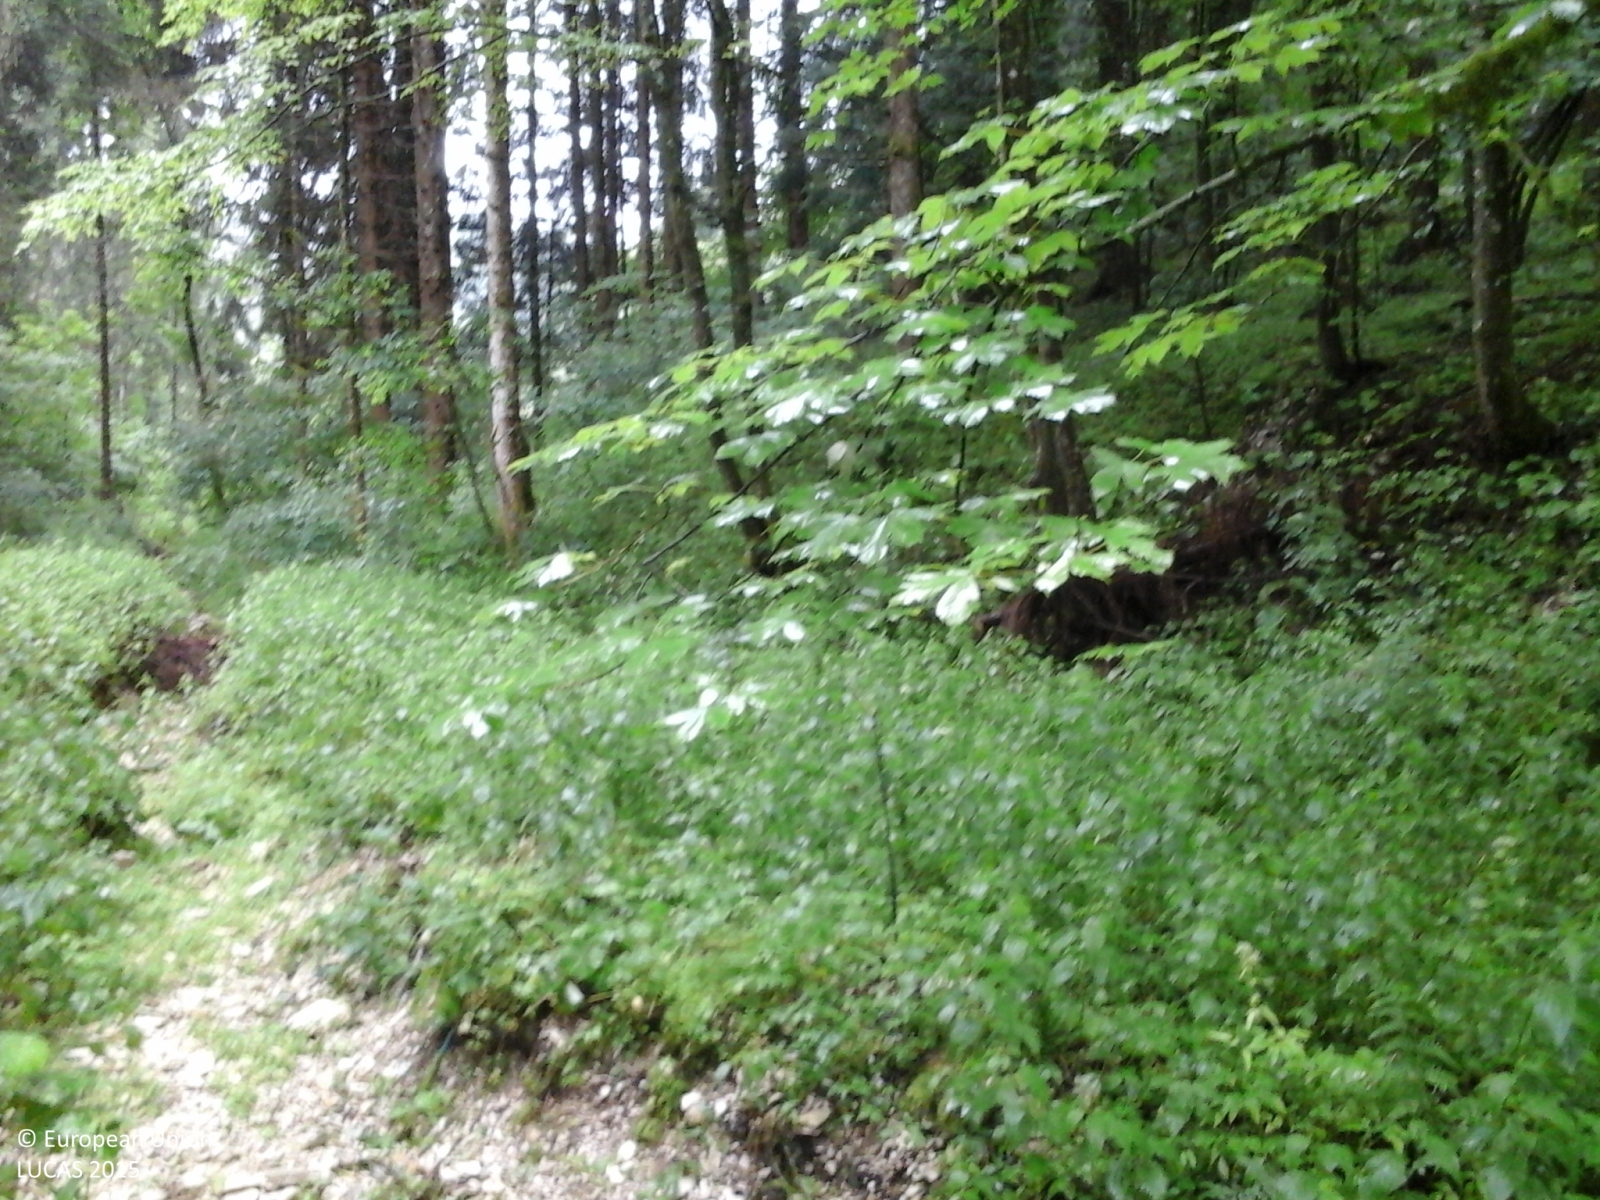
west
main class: Woodland
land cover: Spruce dominated coniferous woodland
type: alpine coniferous forest
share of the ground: > 75 %
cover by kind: coniferous forest trees 80 %, broadleaved forest trees 20 %
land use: Semi-natural and natural areas not in use
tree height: > 5 m
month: June
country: IT
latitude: 45.9059
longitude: 11.6605
